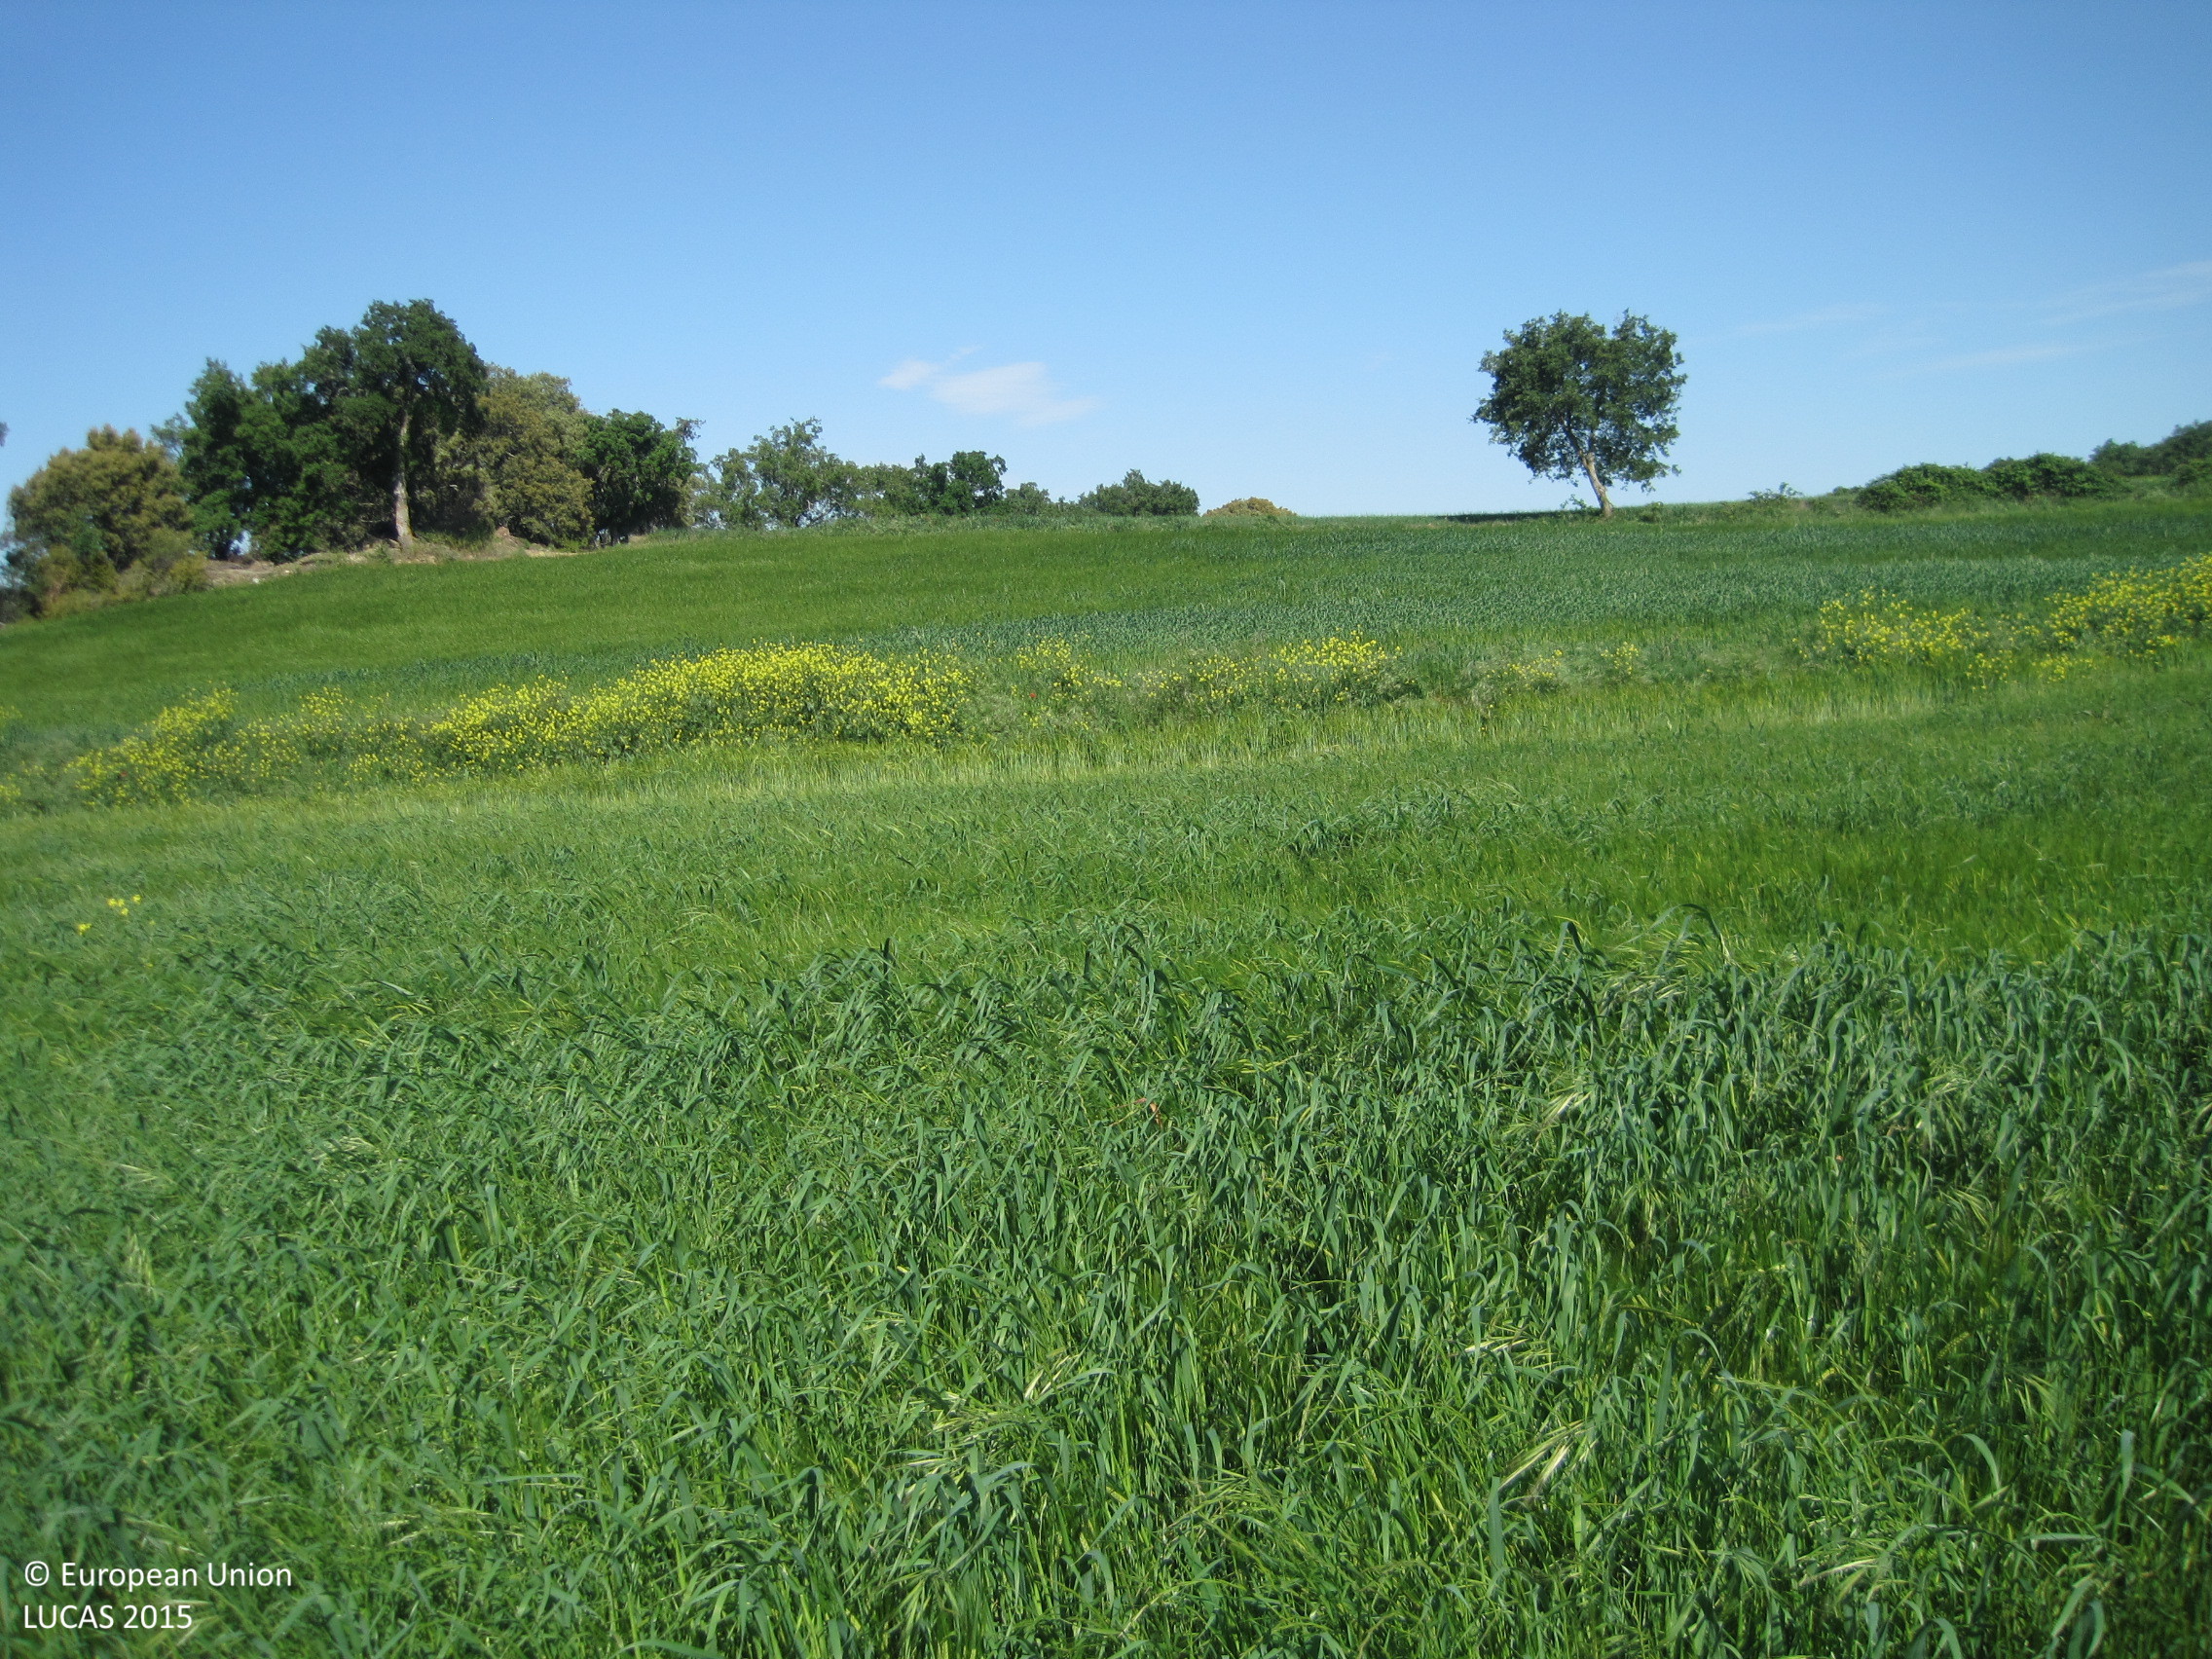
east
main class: Cropland
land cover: Mixed cereals for fodder
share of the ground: > 75 %
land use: Agriculture (excluding fallow land and kitchen gardens)
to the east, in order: Mixed cereals for fodder; Common wheat; Grass margins; Common wheat; Broadleaved woodland; Mixed cereals for fodder
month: May
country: ES
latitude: 42.5548
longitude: -1.7173
